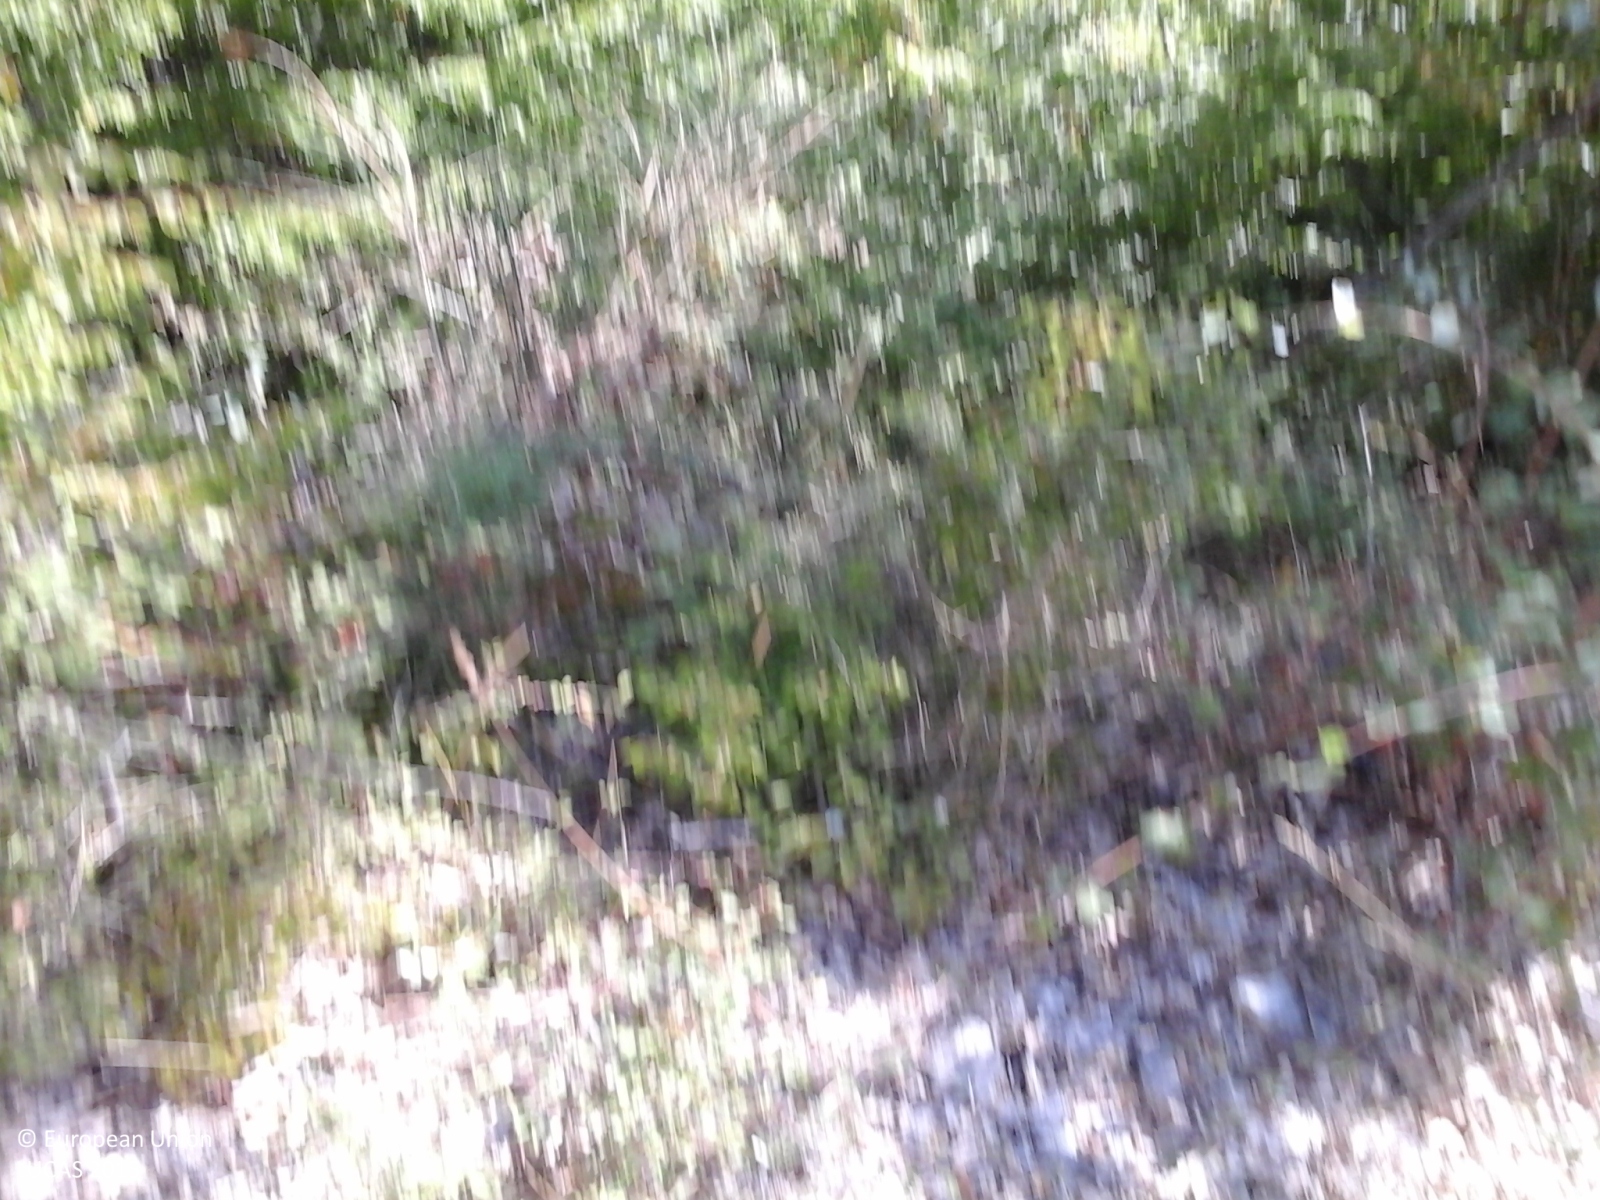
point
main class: Woodland
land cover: Broadleaved woodland
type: thermophilous deciduous forest
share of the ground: > 75 %
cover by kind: broadleaved forest trees 75 %, shrubs 15 %, herbaceous plants 10 %
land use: Semi-natural and natural areas not in use
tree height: > 5 m
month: September
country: IT
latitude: 41.6995
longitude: 14.1790
